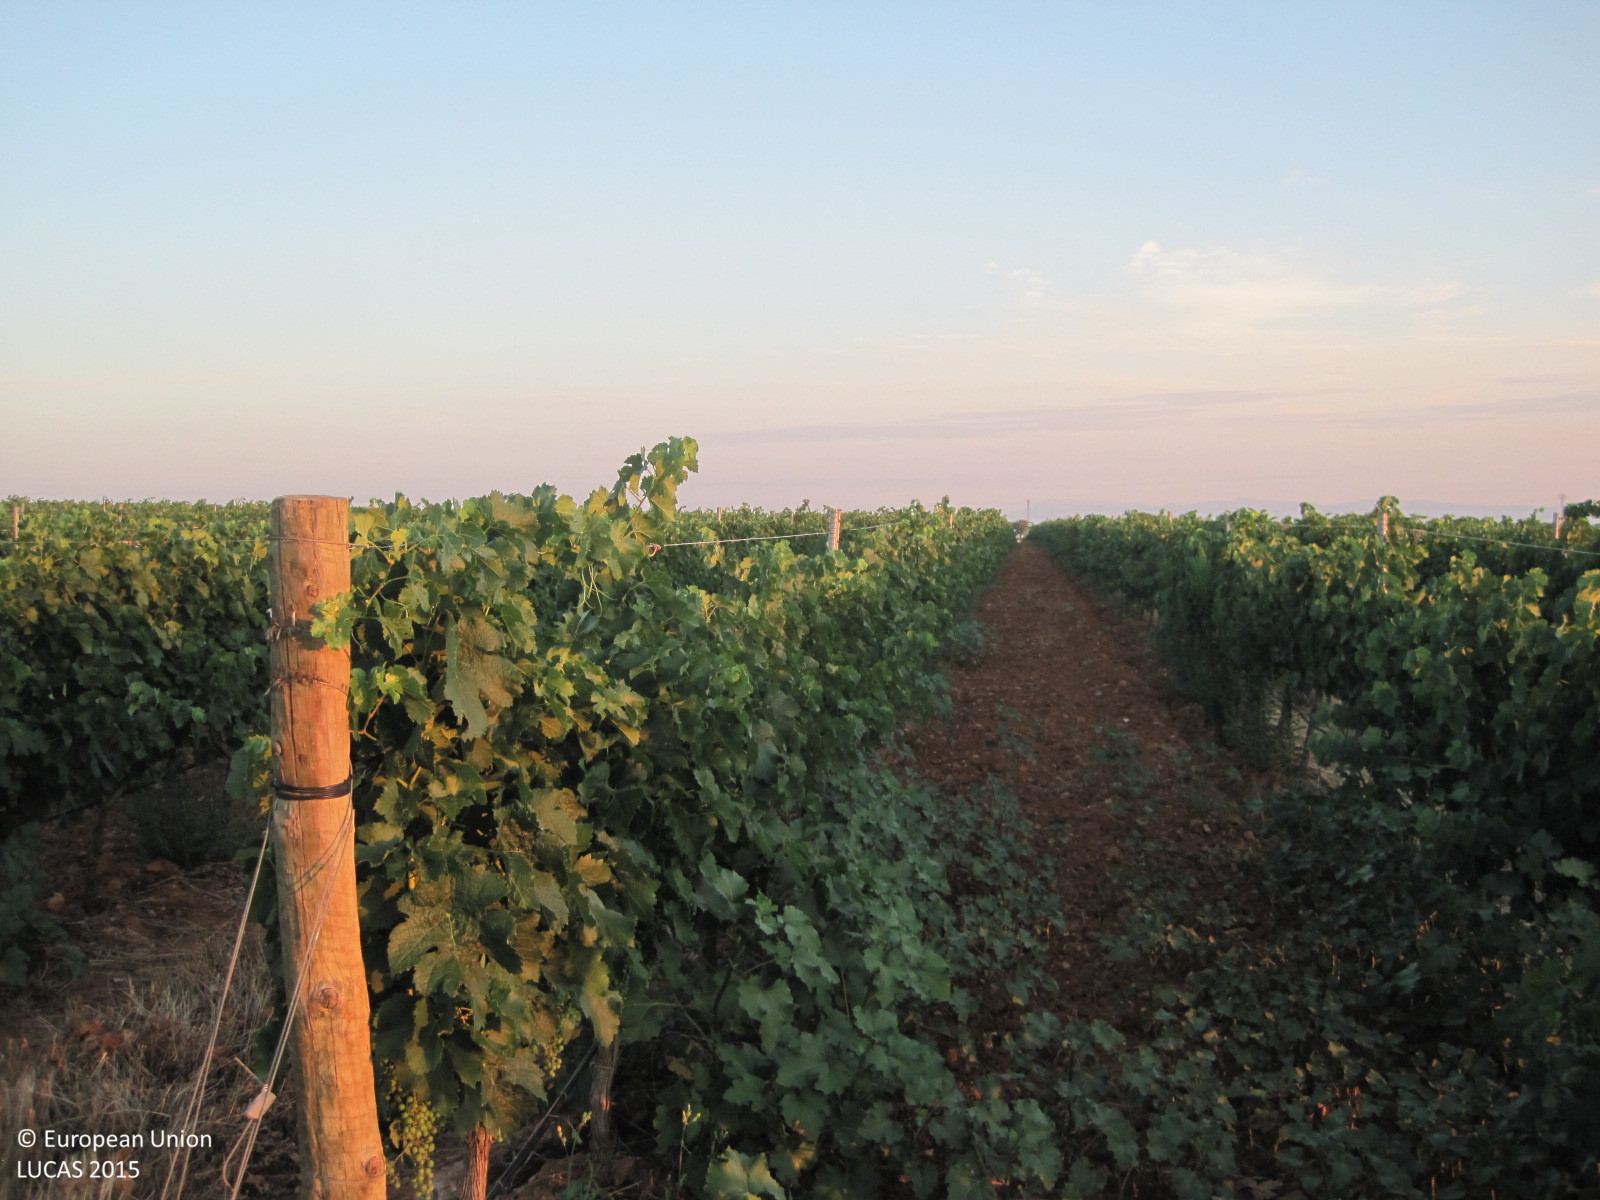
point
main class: Cropland
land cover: Vineyards
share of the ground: > 75 %
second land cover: Other bare soil
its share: > 75 %
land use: Agriculture (excluding fallow land and kitchen gardens)
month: June
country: ES
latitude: 39.8772
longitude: -4.6474
